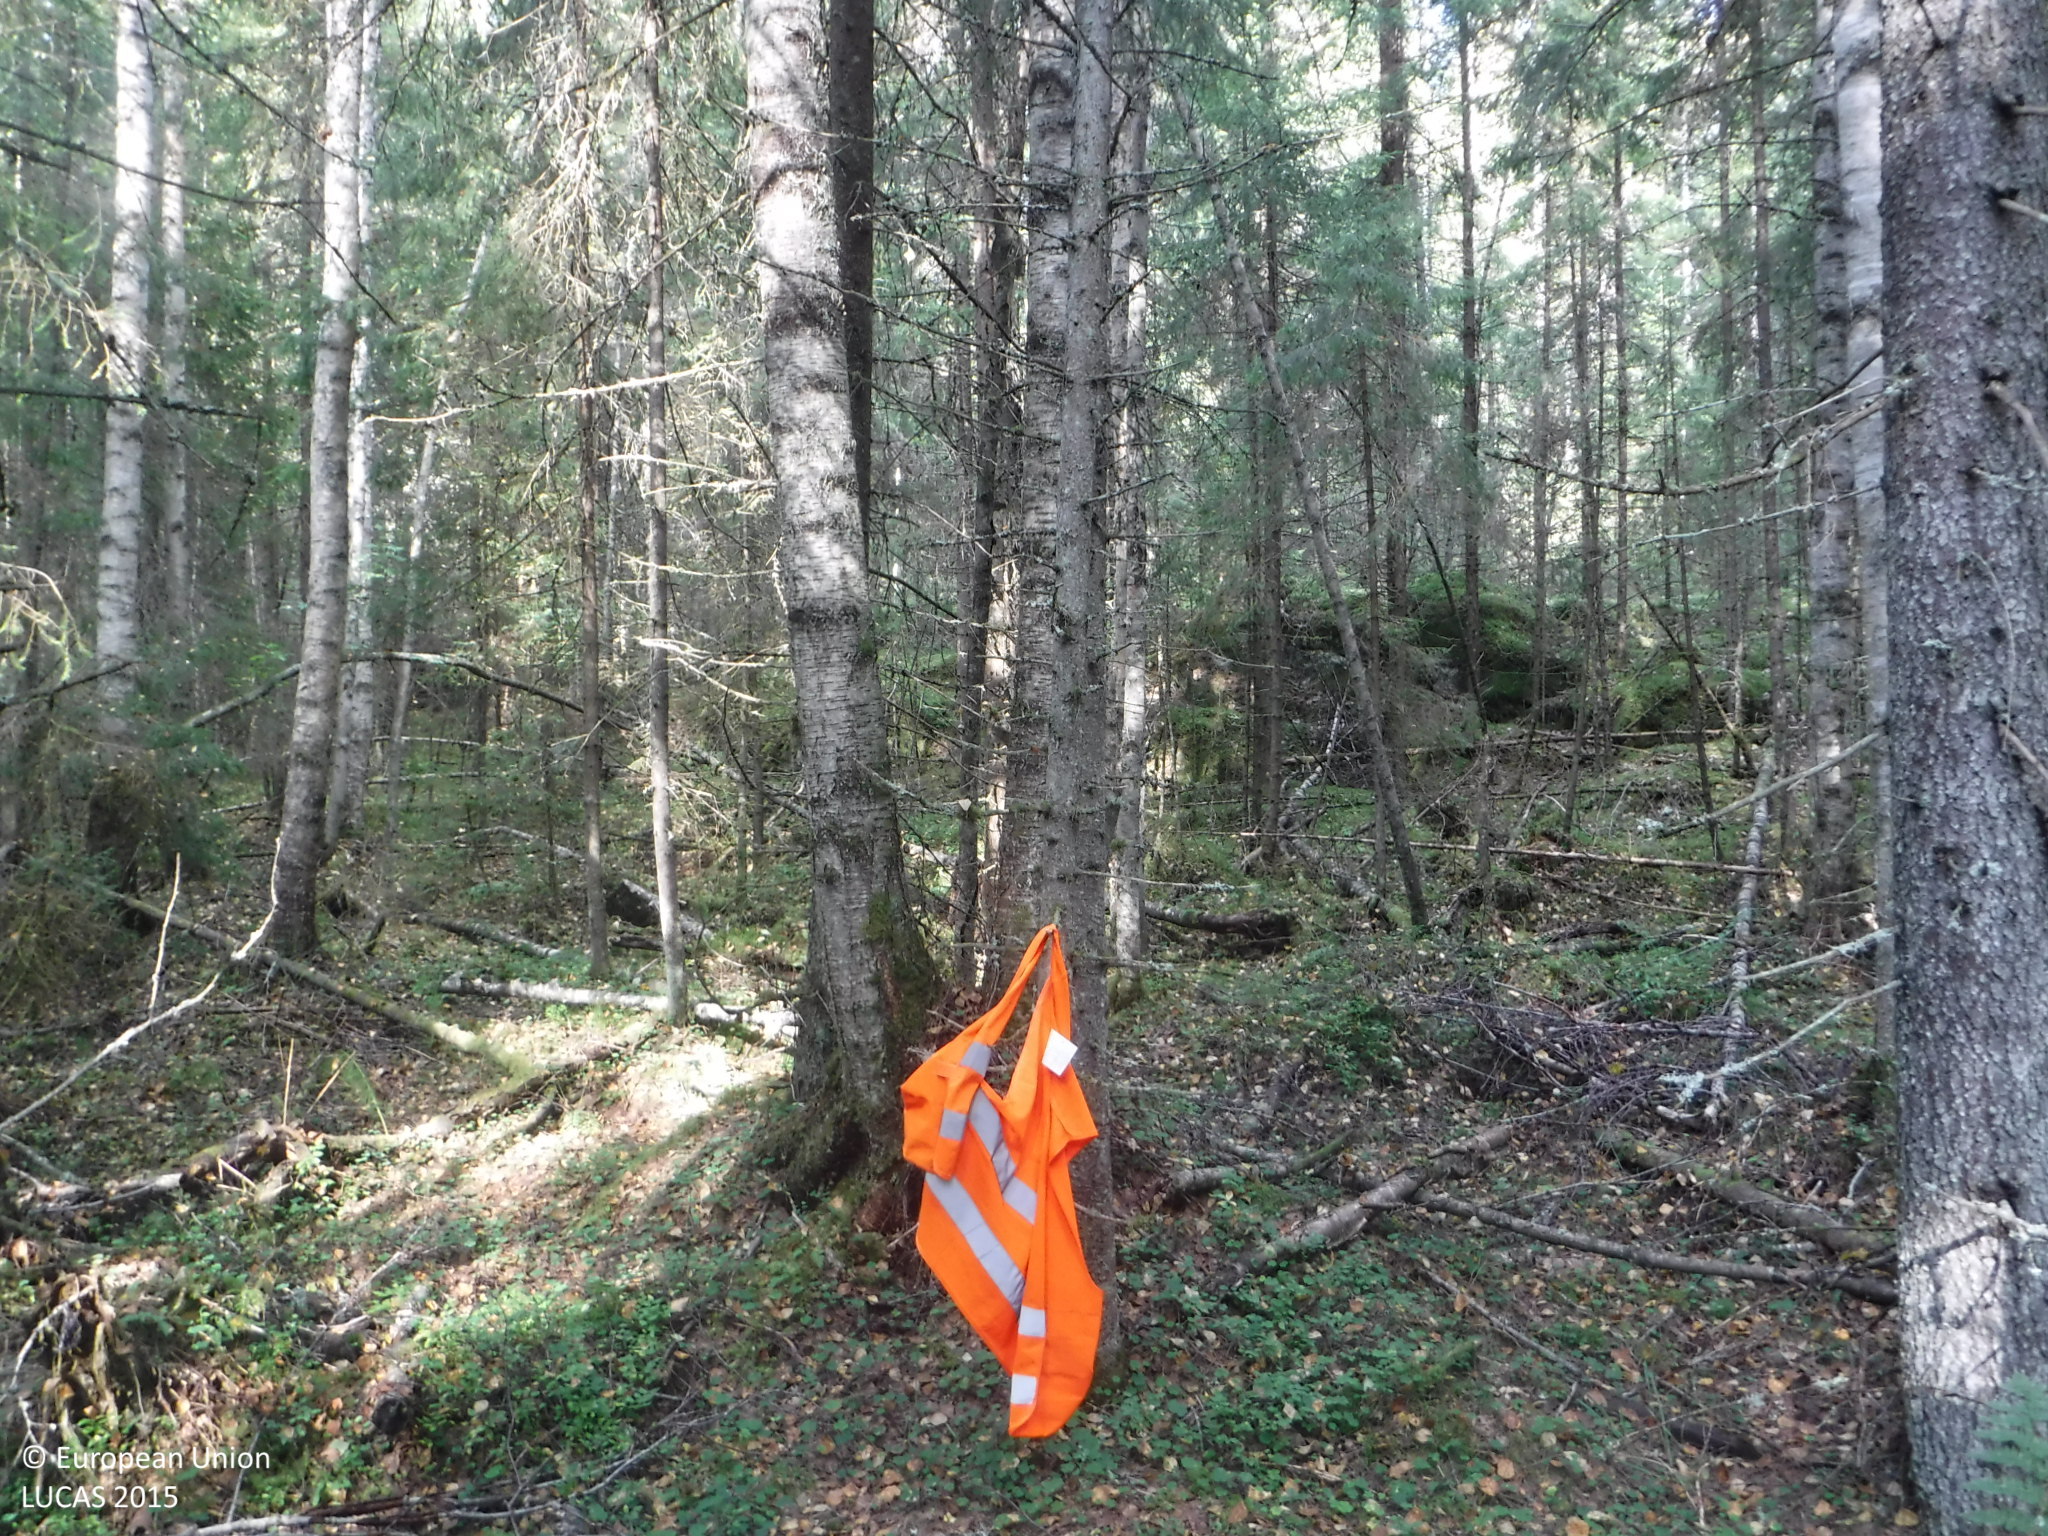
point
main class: Woodland
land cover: Spruce dominated mixed woodland
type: boreal forest
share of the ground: > 75 %
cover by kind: coniferous forest trees 45 %, broadleaved forest trees 30 %, herbaceous plants 15 %, lichens and mosses 10 %
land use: Forestry
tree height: > 5 m
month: September
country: FI
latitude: 61.6979
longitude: 22.3685
